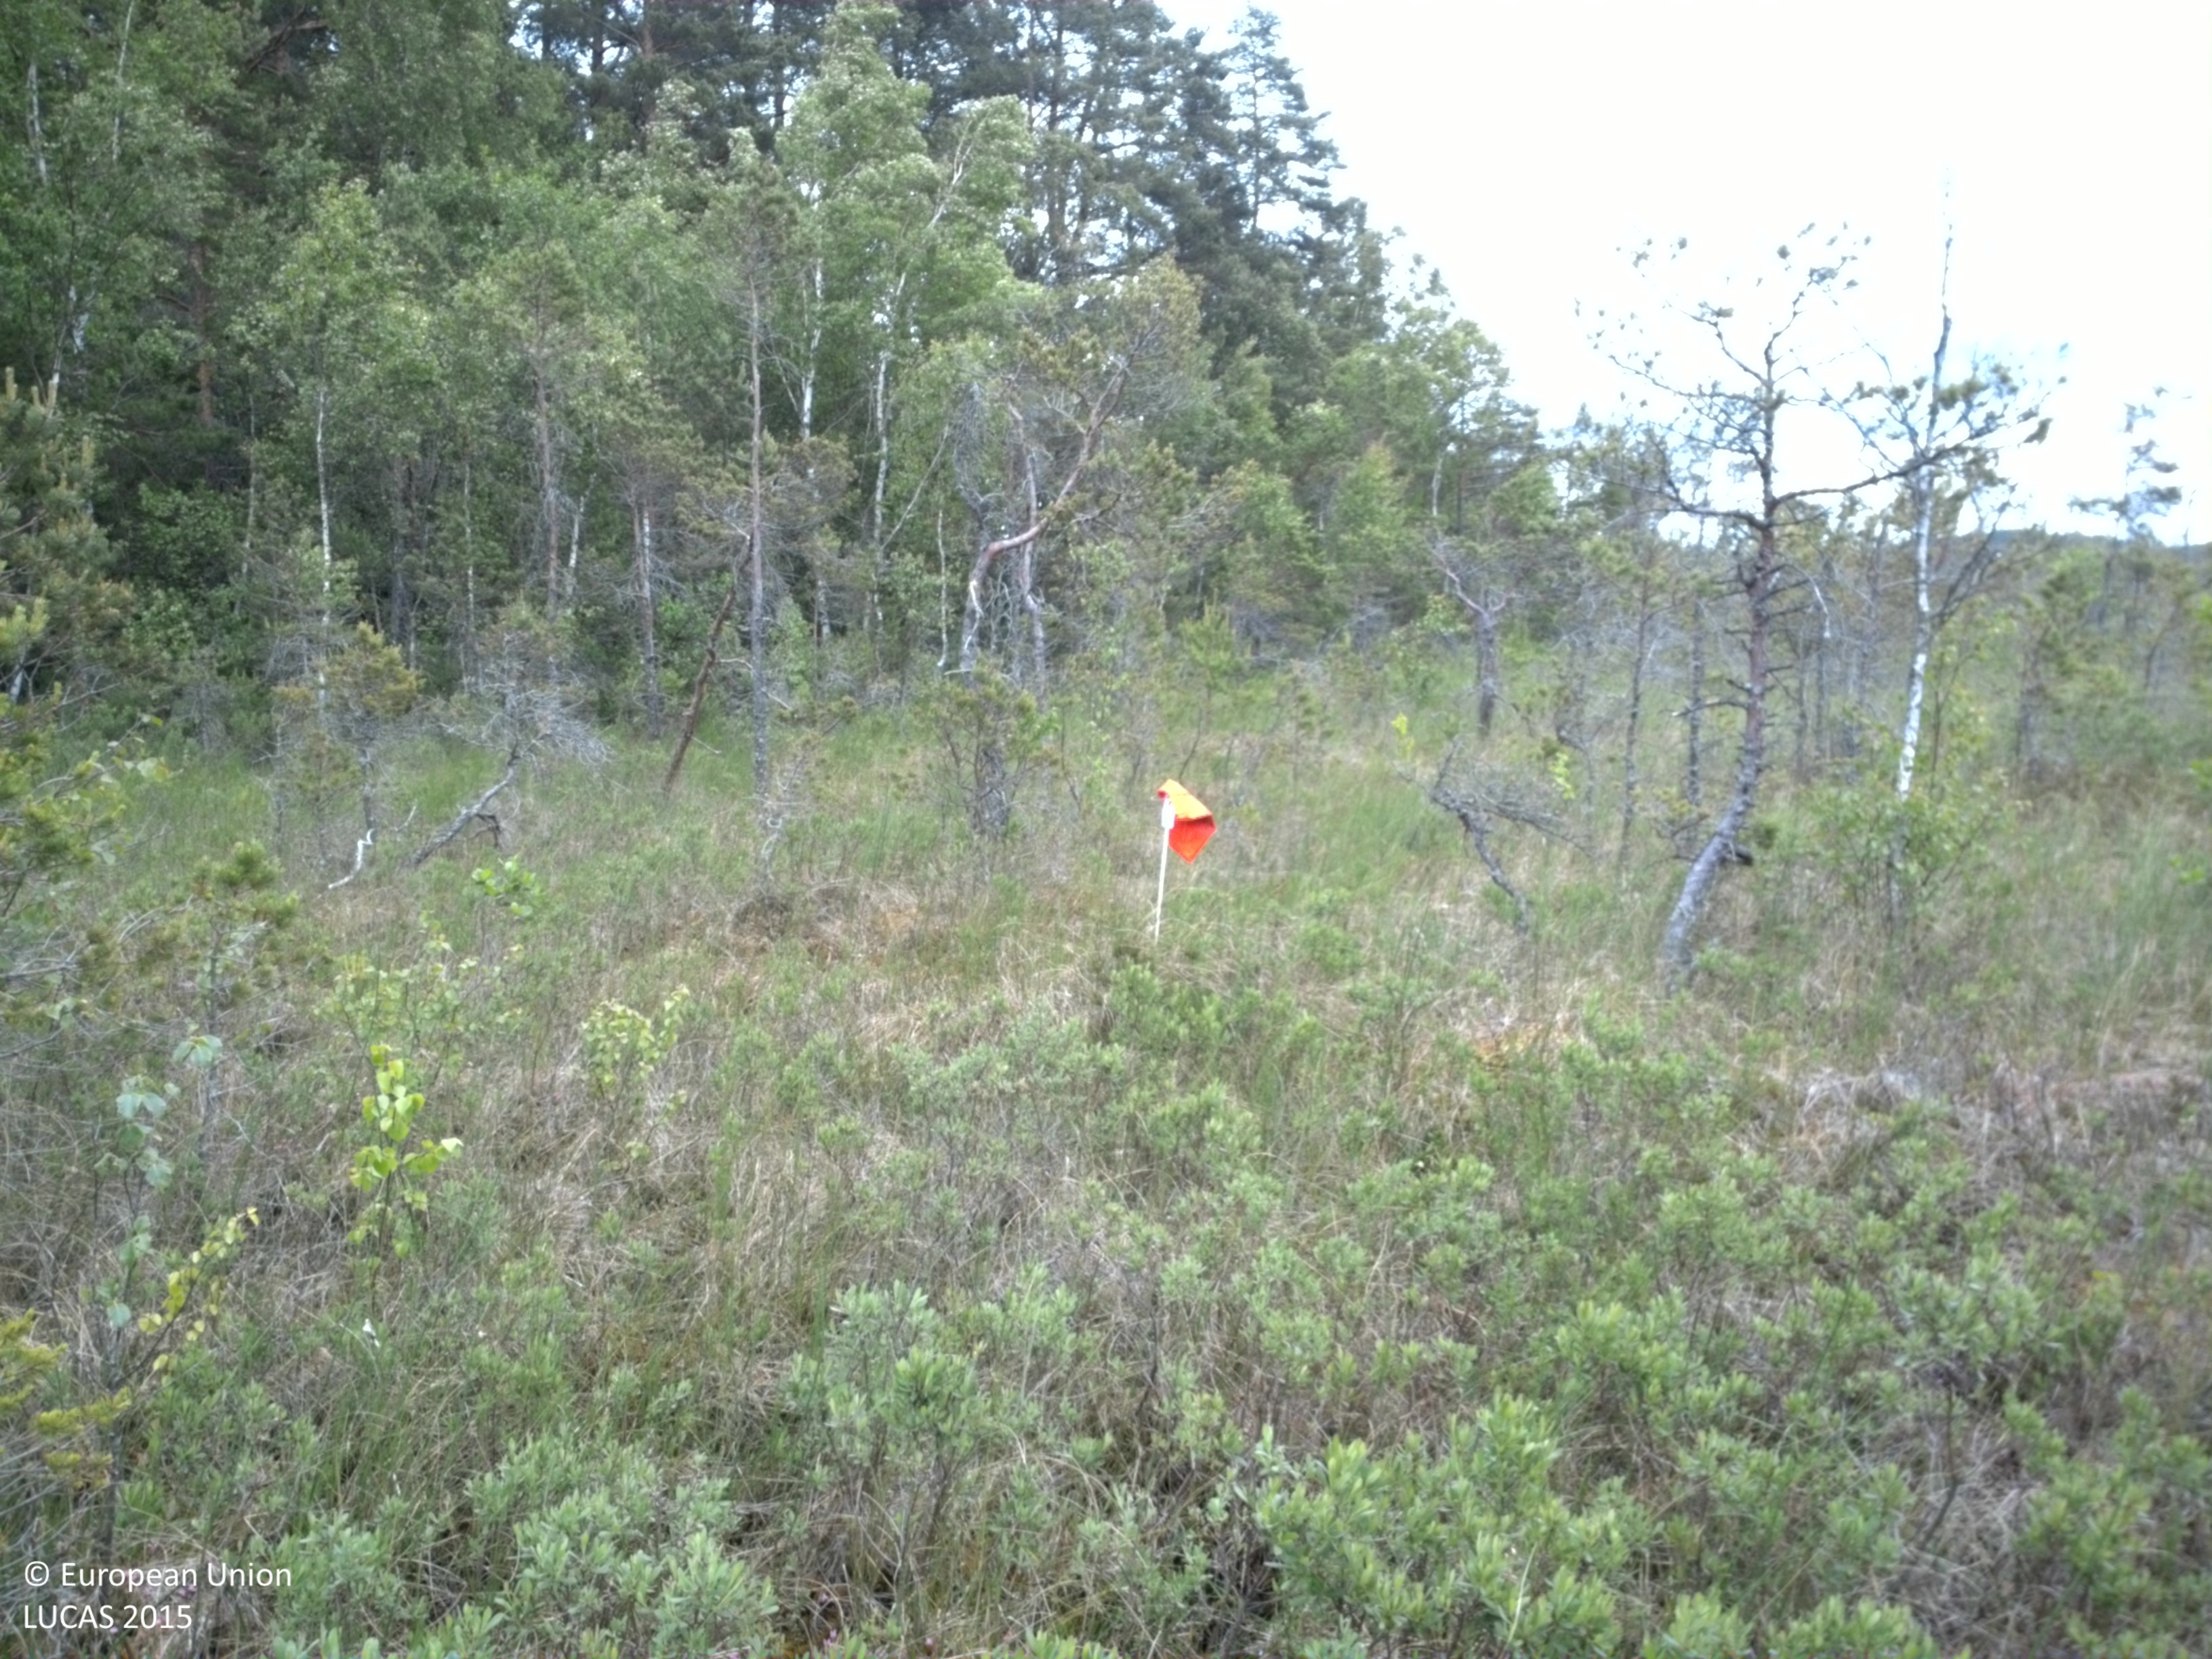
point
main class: Woodland
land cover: Pine dominated coniferous woodland
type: boreal forest
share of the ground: 10 - 25 %
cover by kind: lichens and mosses 50 %, herbaceous plants 35 %, coniferous forest trees 15 %
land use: Semi-natural and natural areas not in use
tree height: < 5 m
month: June
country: SE
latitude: 58.5264
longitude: 16.2288
